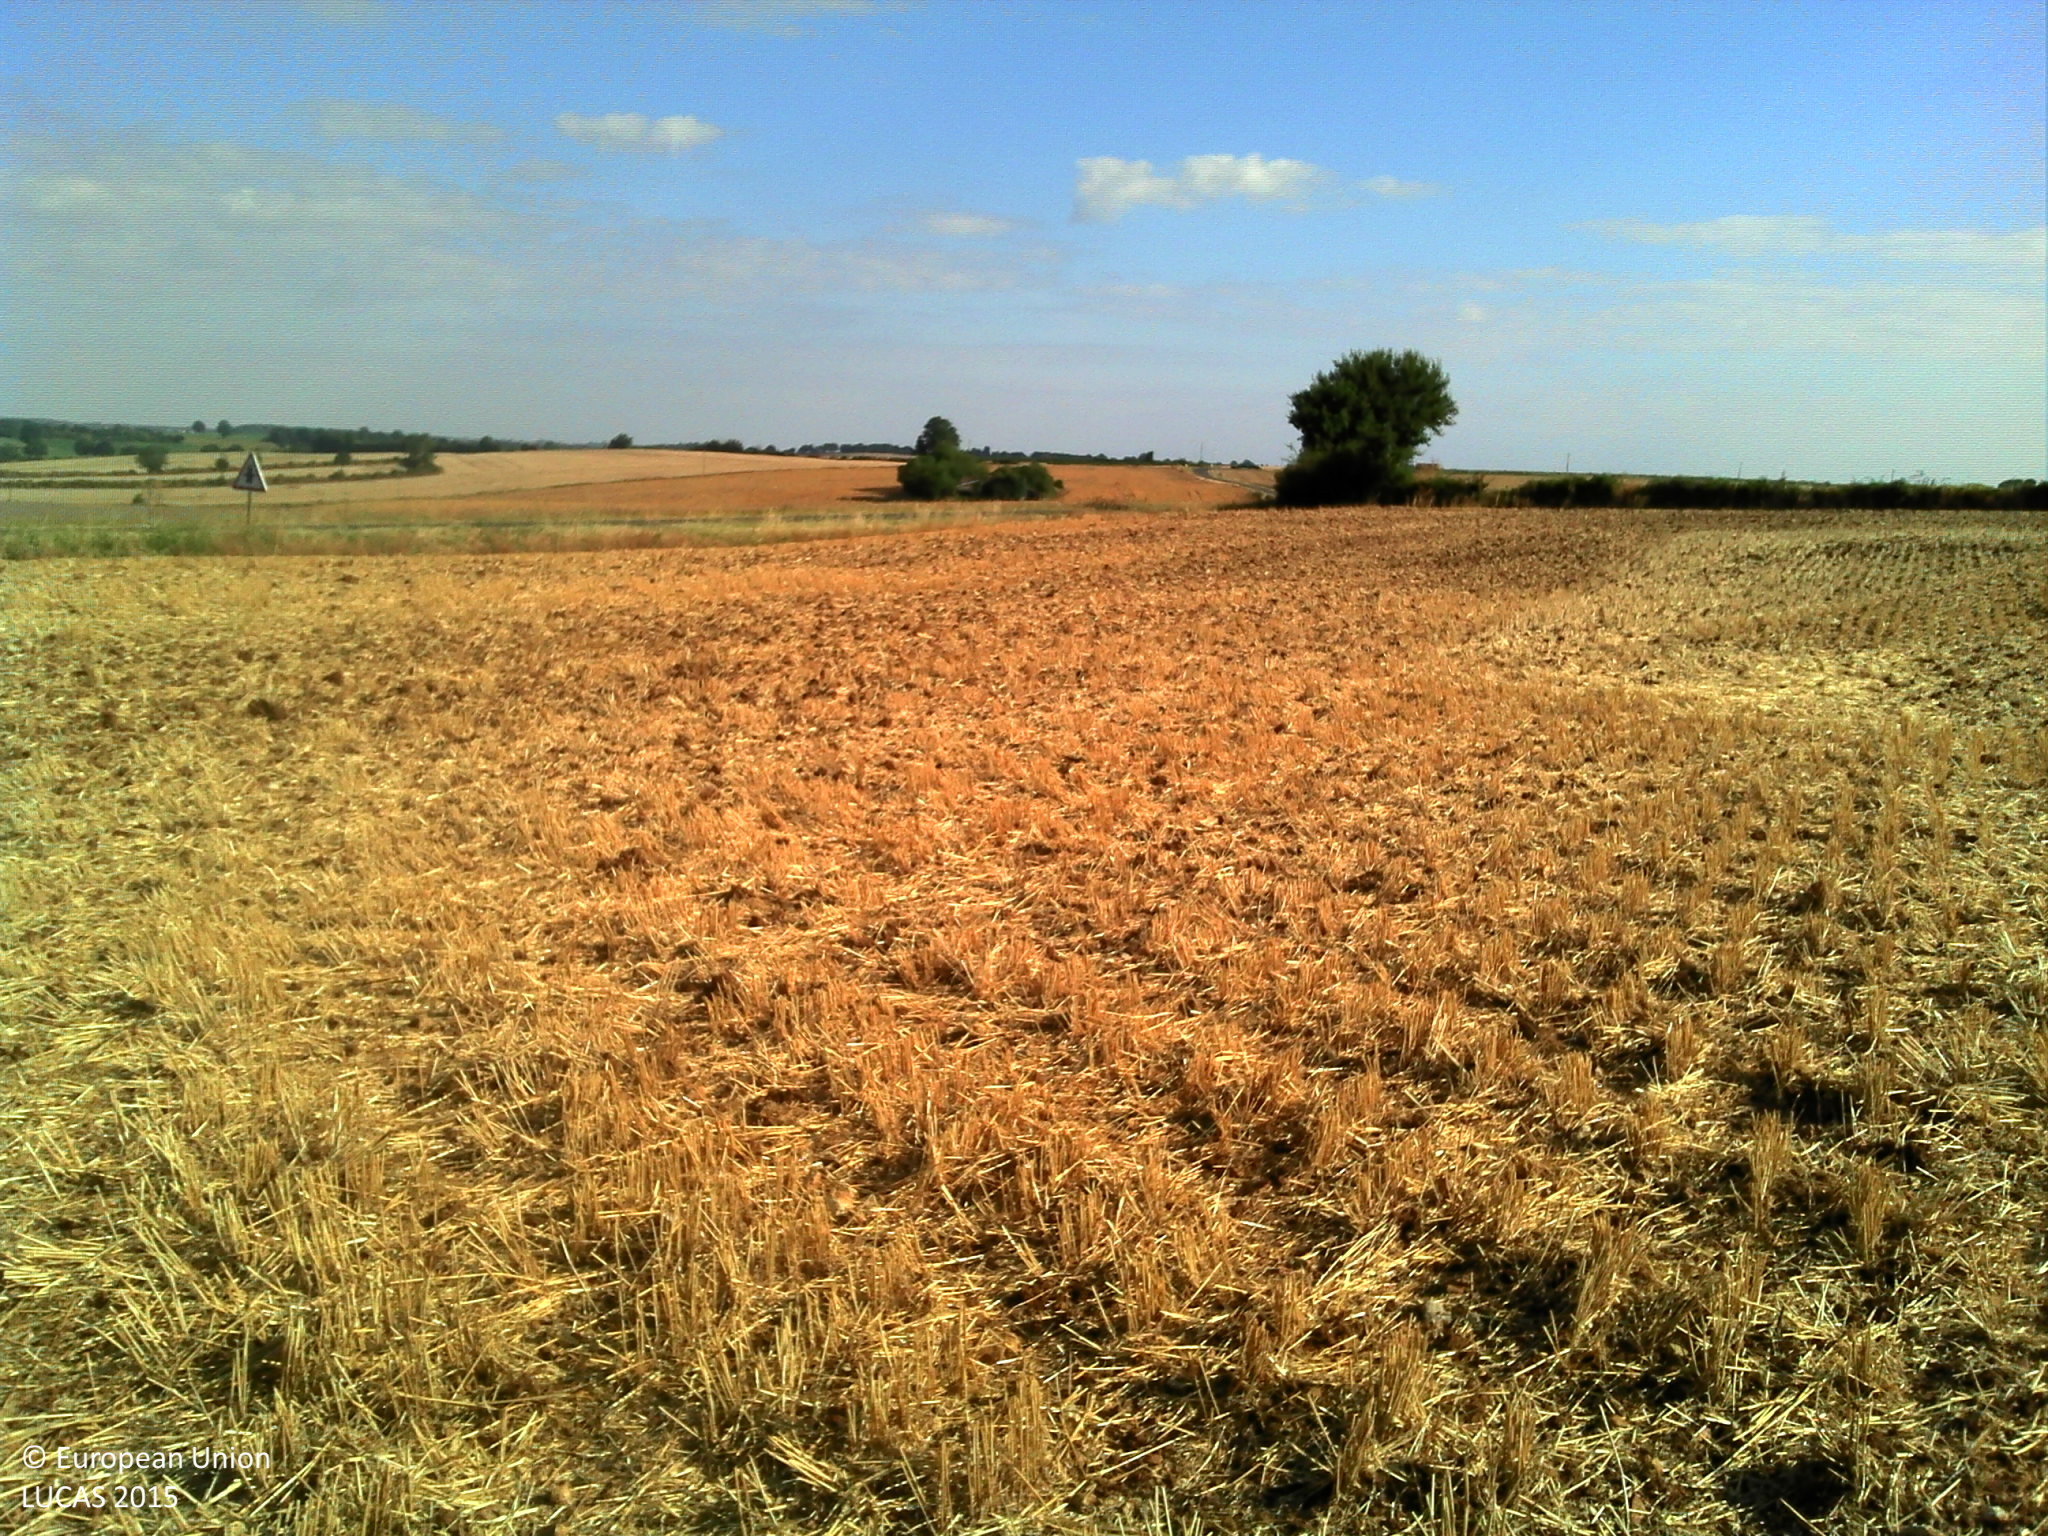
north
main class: Cropland
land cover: Common wheat
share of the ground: > 75 %
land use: Agriculture (excluding fallow land and kitchen gardens)
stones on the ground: 10 - 25 %
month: July
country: FR
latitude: 46.5908
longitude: 2.2013
